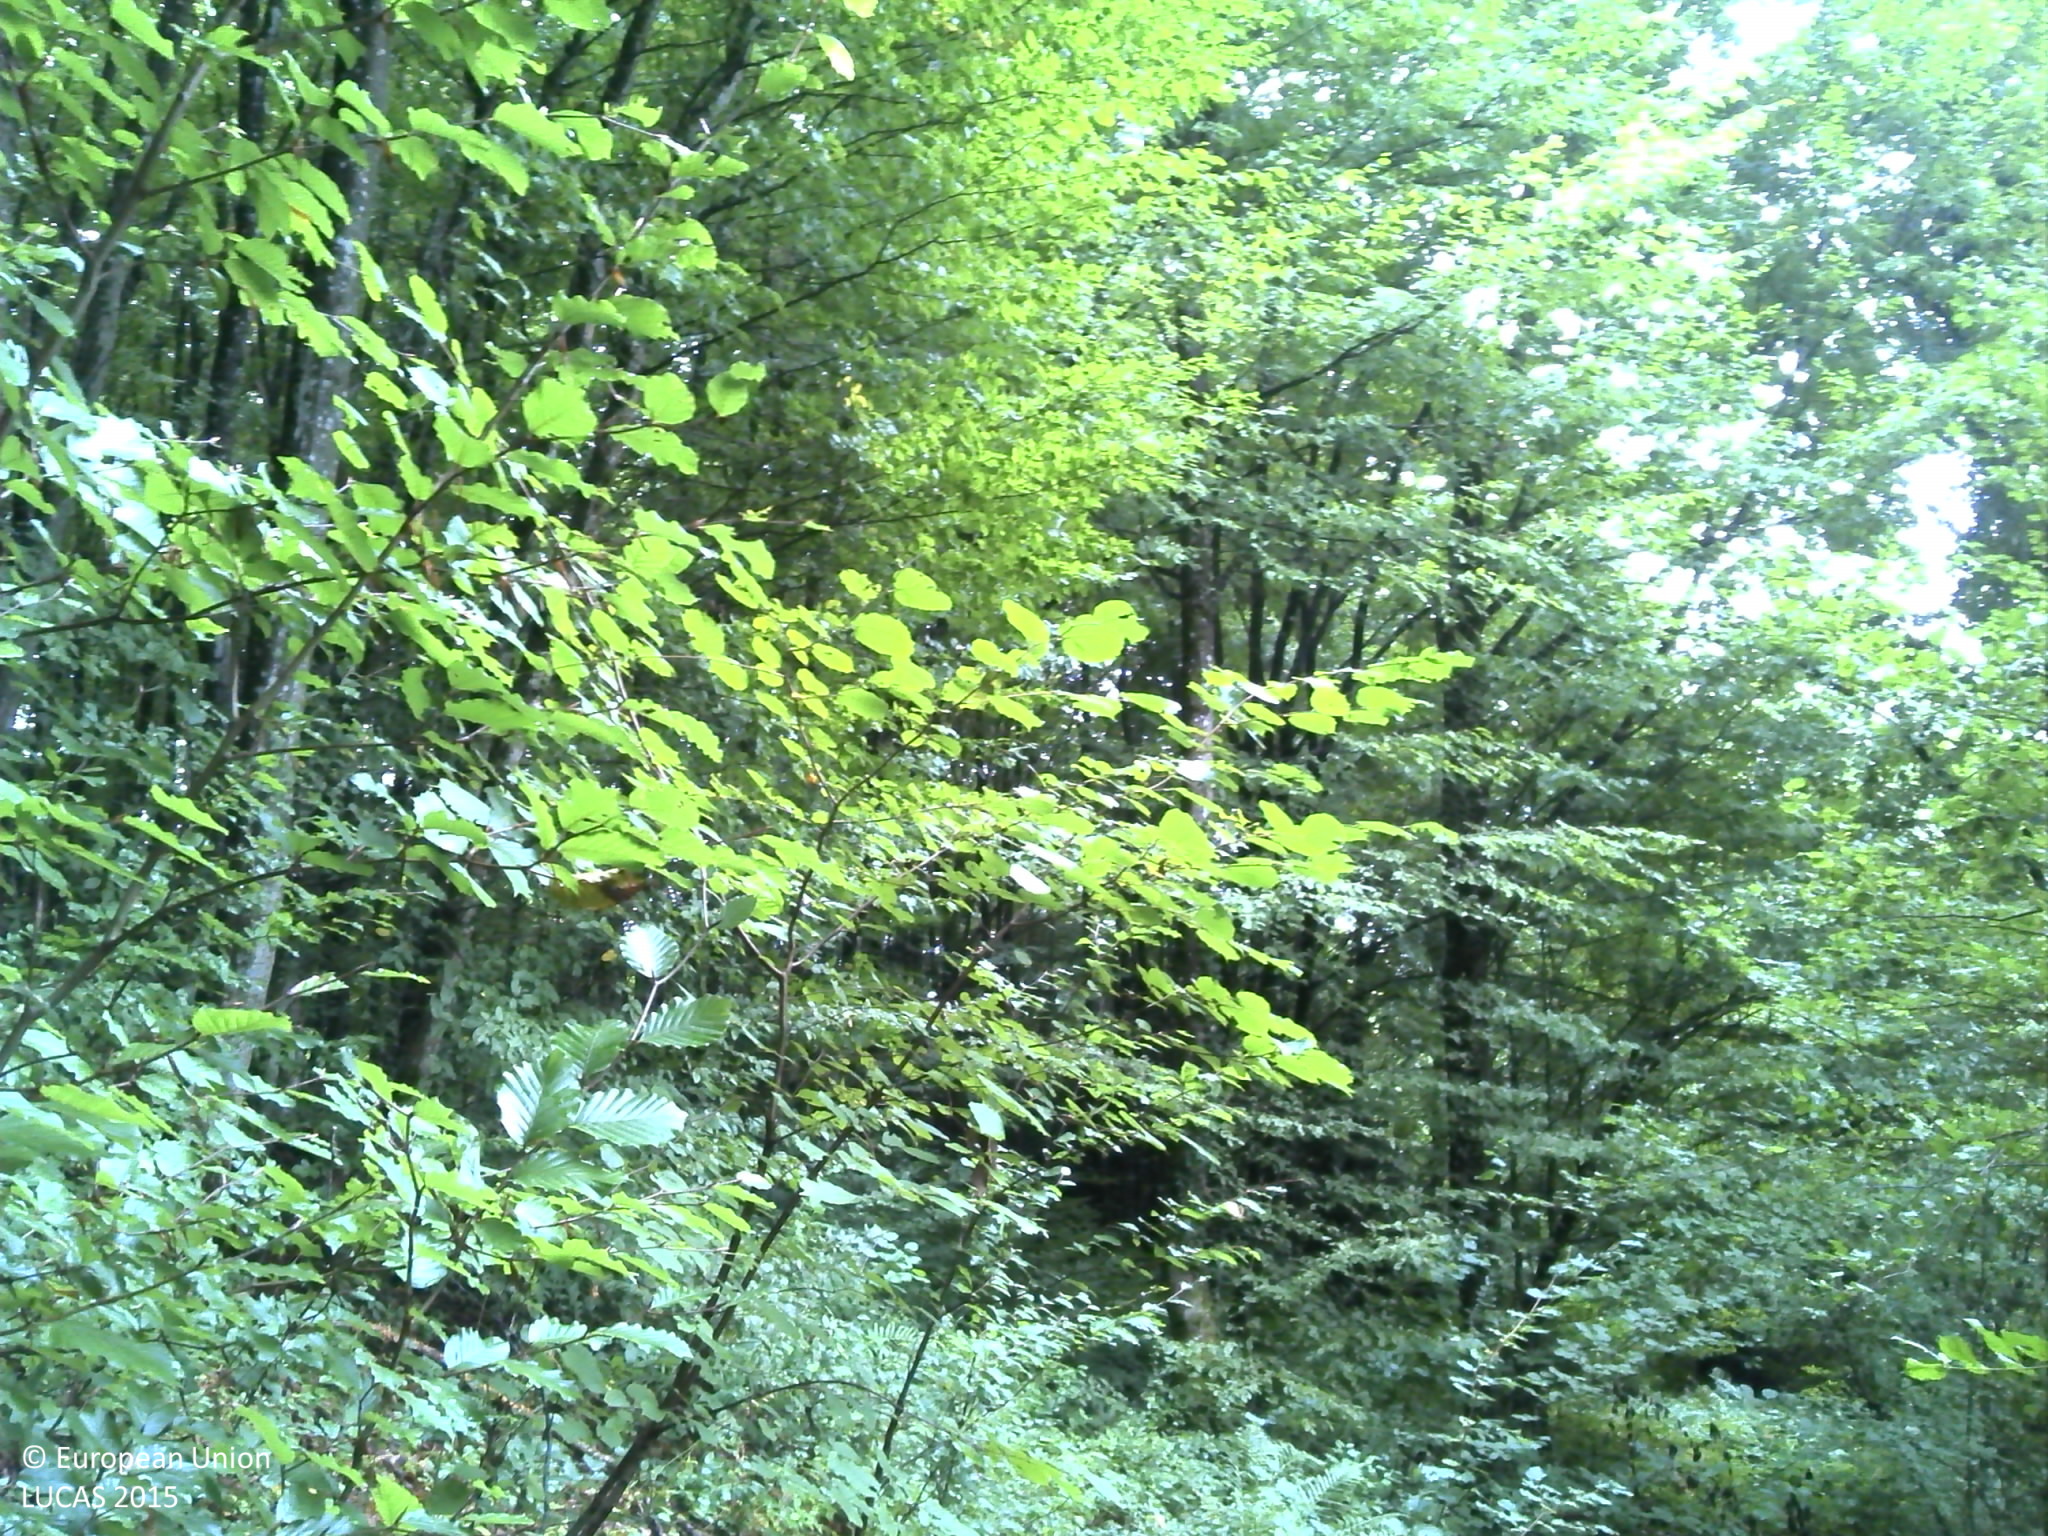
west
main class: Woodland
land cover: Broadleaved woodland
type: beech forest
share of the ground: > 75 %
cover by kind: broadleaved forest trees 100 %
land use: Forestry
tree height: > 5 m
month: August
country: HR
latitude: 45.3724
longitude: 15.6271
